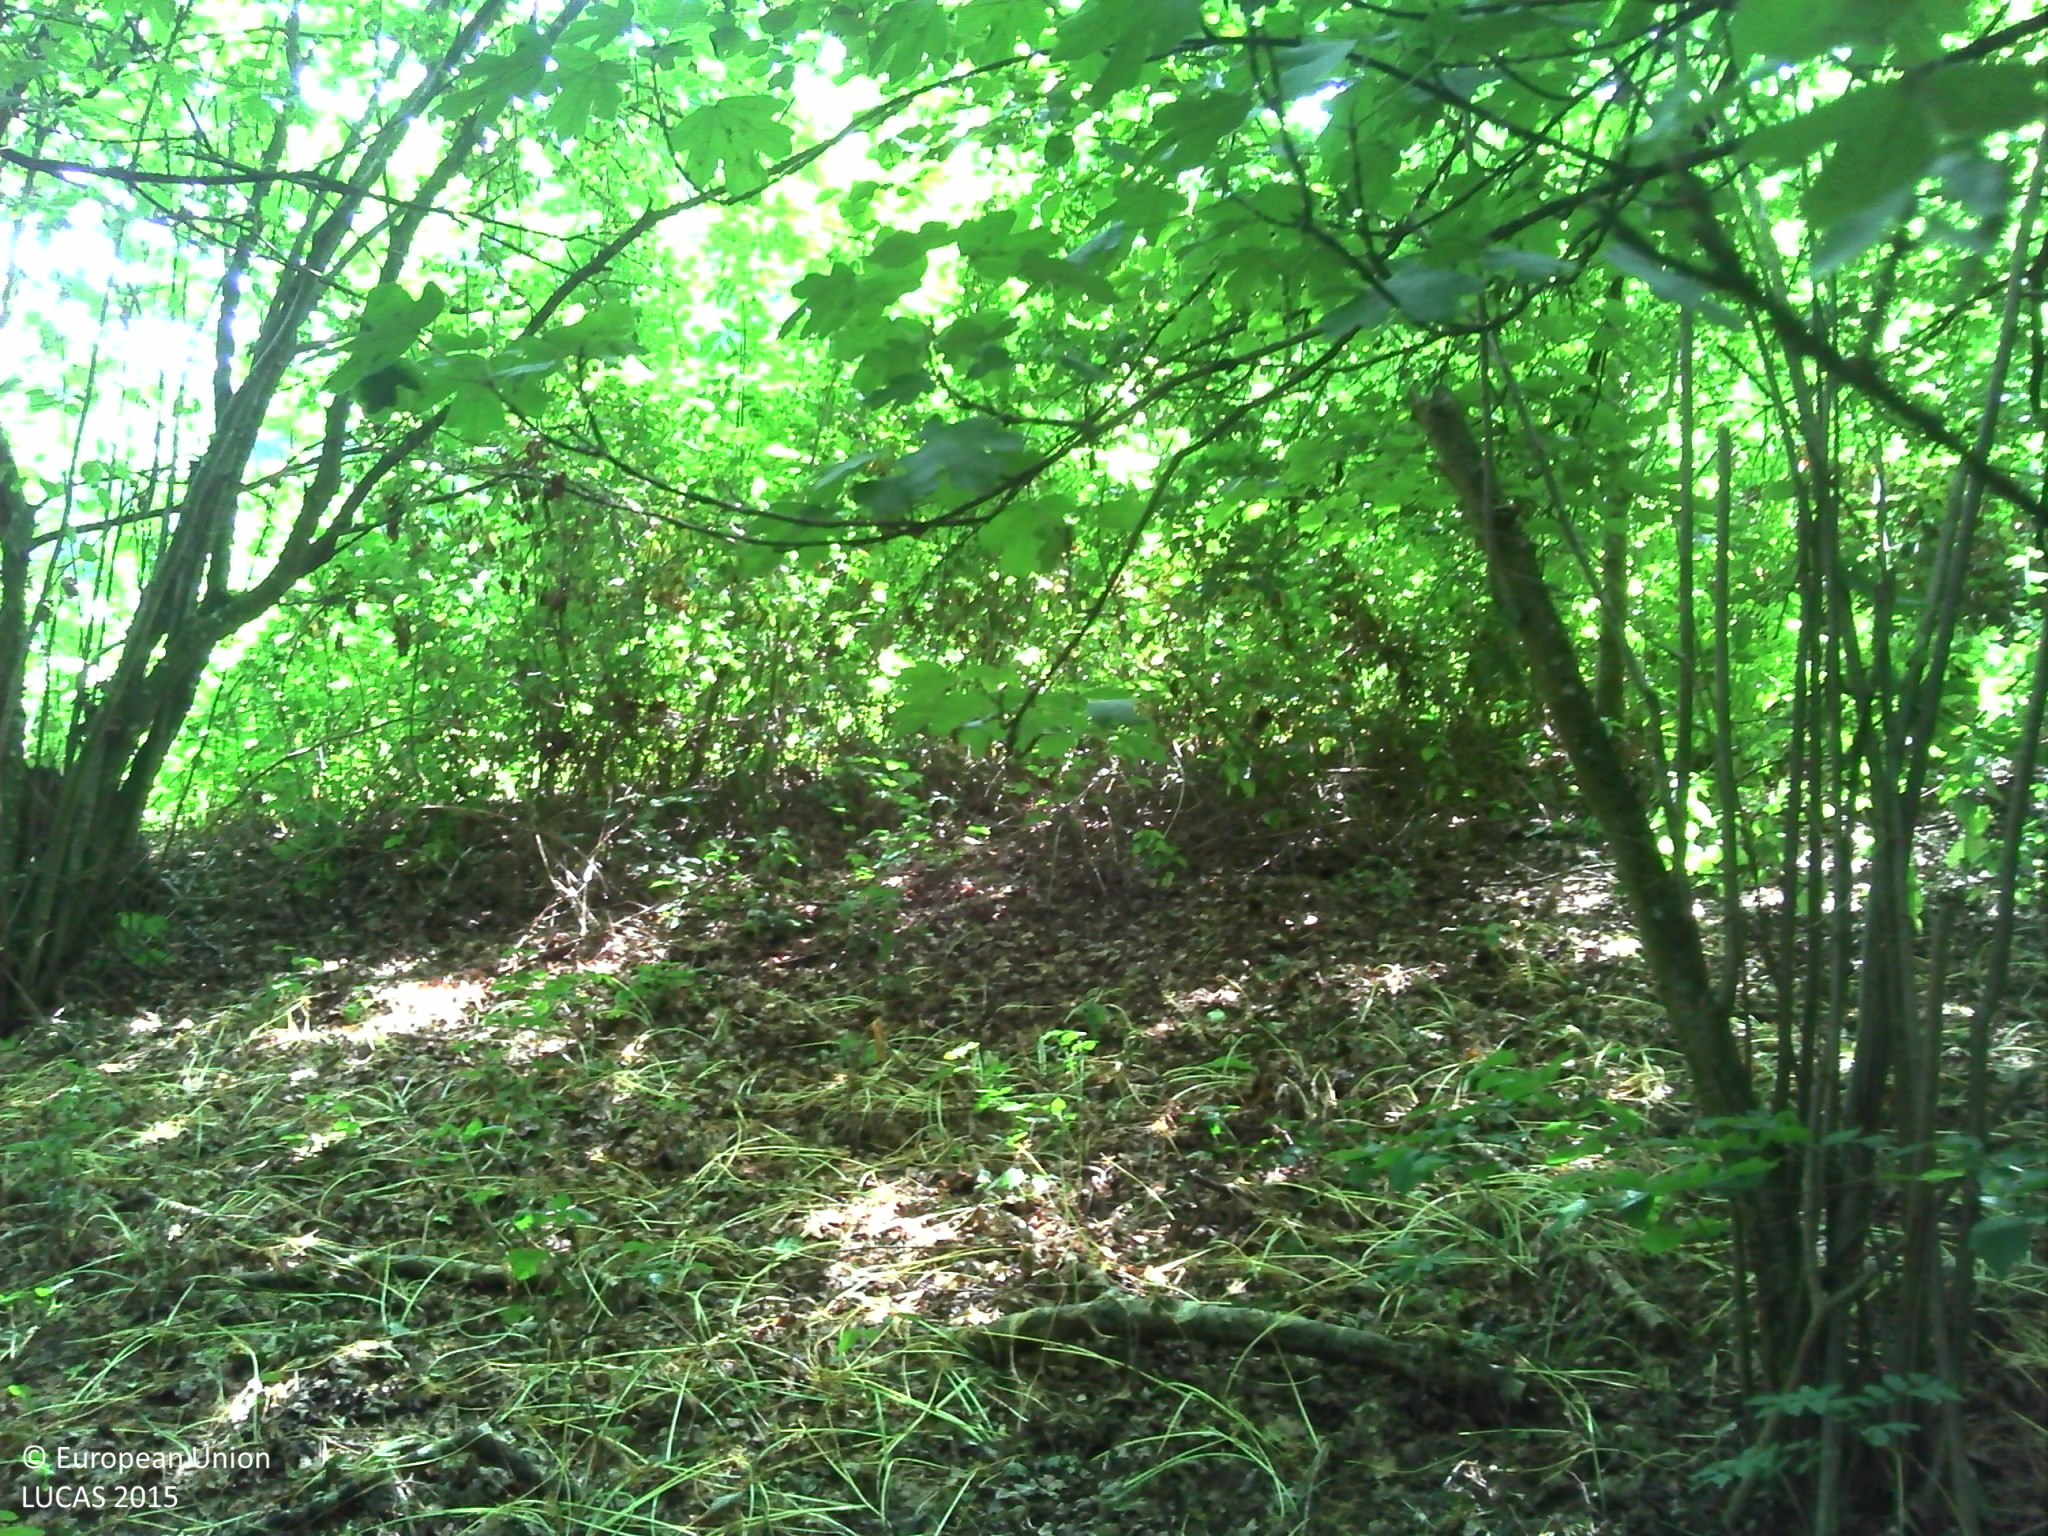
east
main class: Woodland
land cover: Broadleaved woodland
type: mesophytic deciduous forest
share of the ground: > 75 %
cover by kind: broadleaved forest trees 80 %, herbaceous plants 10 %, lichens and mosses 5 %, consolidated bare surface 5 %
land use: Forestry
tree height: > 5 m
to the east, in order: Broadleaved woodland; Tracks; Fences; Grassland without tree/shrub cover; Broadleaved woodland; Grassland without tree/shrub cover; Broadleaved woodland; Tracks; Broadleaved woodland
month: June
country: FR
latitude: 49.1887
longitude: 1.1568
